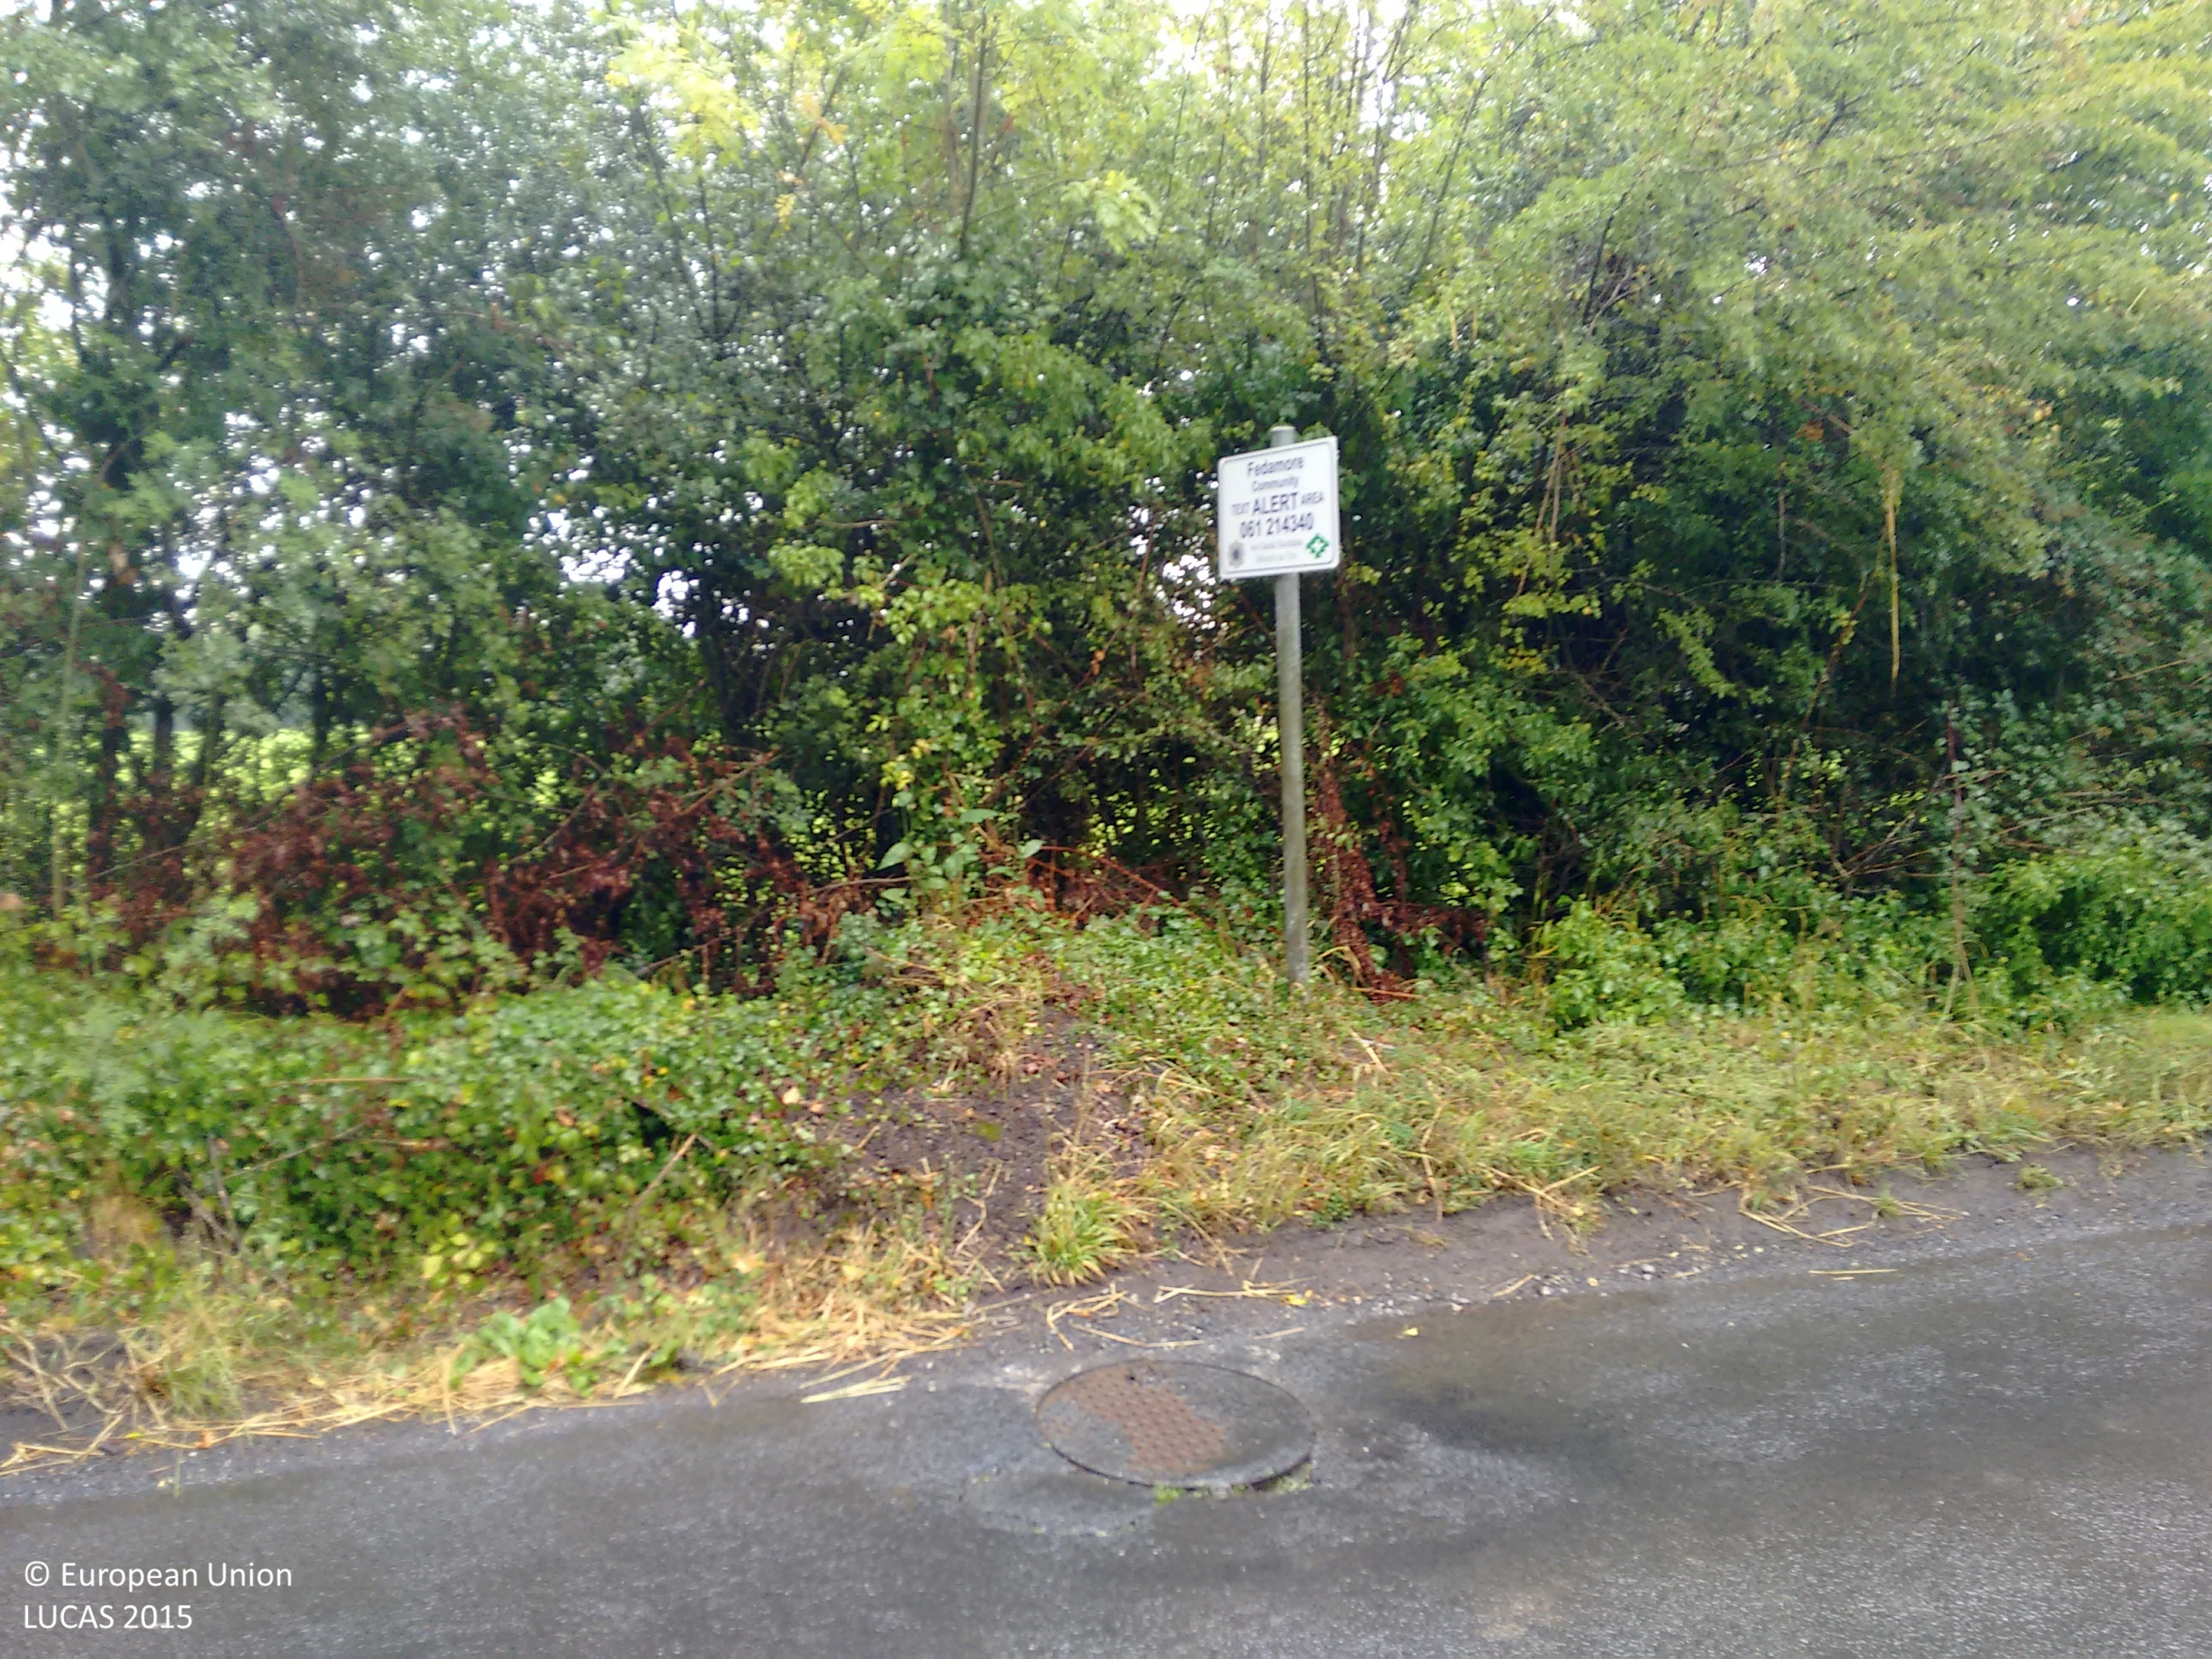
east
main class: Grassland
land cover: Grassland with sparse tree/shrub cover
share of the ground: > 75 %
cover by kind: herbaceous plants 95 %, broadleaved forest trees 5 %
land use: Residential
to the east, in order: Grassland with sparse tree/shrub cover; Artificial constructions in urban areas; Abandoned hedges; Ditches and canals; Abandoned hedges; Fences; Grassland without tree/shrub cover; Fences; Lines of trees; Artificial constructions in urban areas; Abandoned hedges; Fences; Grassland without tree/shrub cover
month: September
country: IE
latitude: 52.5831
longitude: -8.6325
